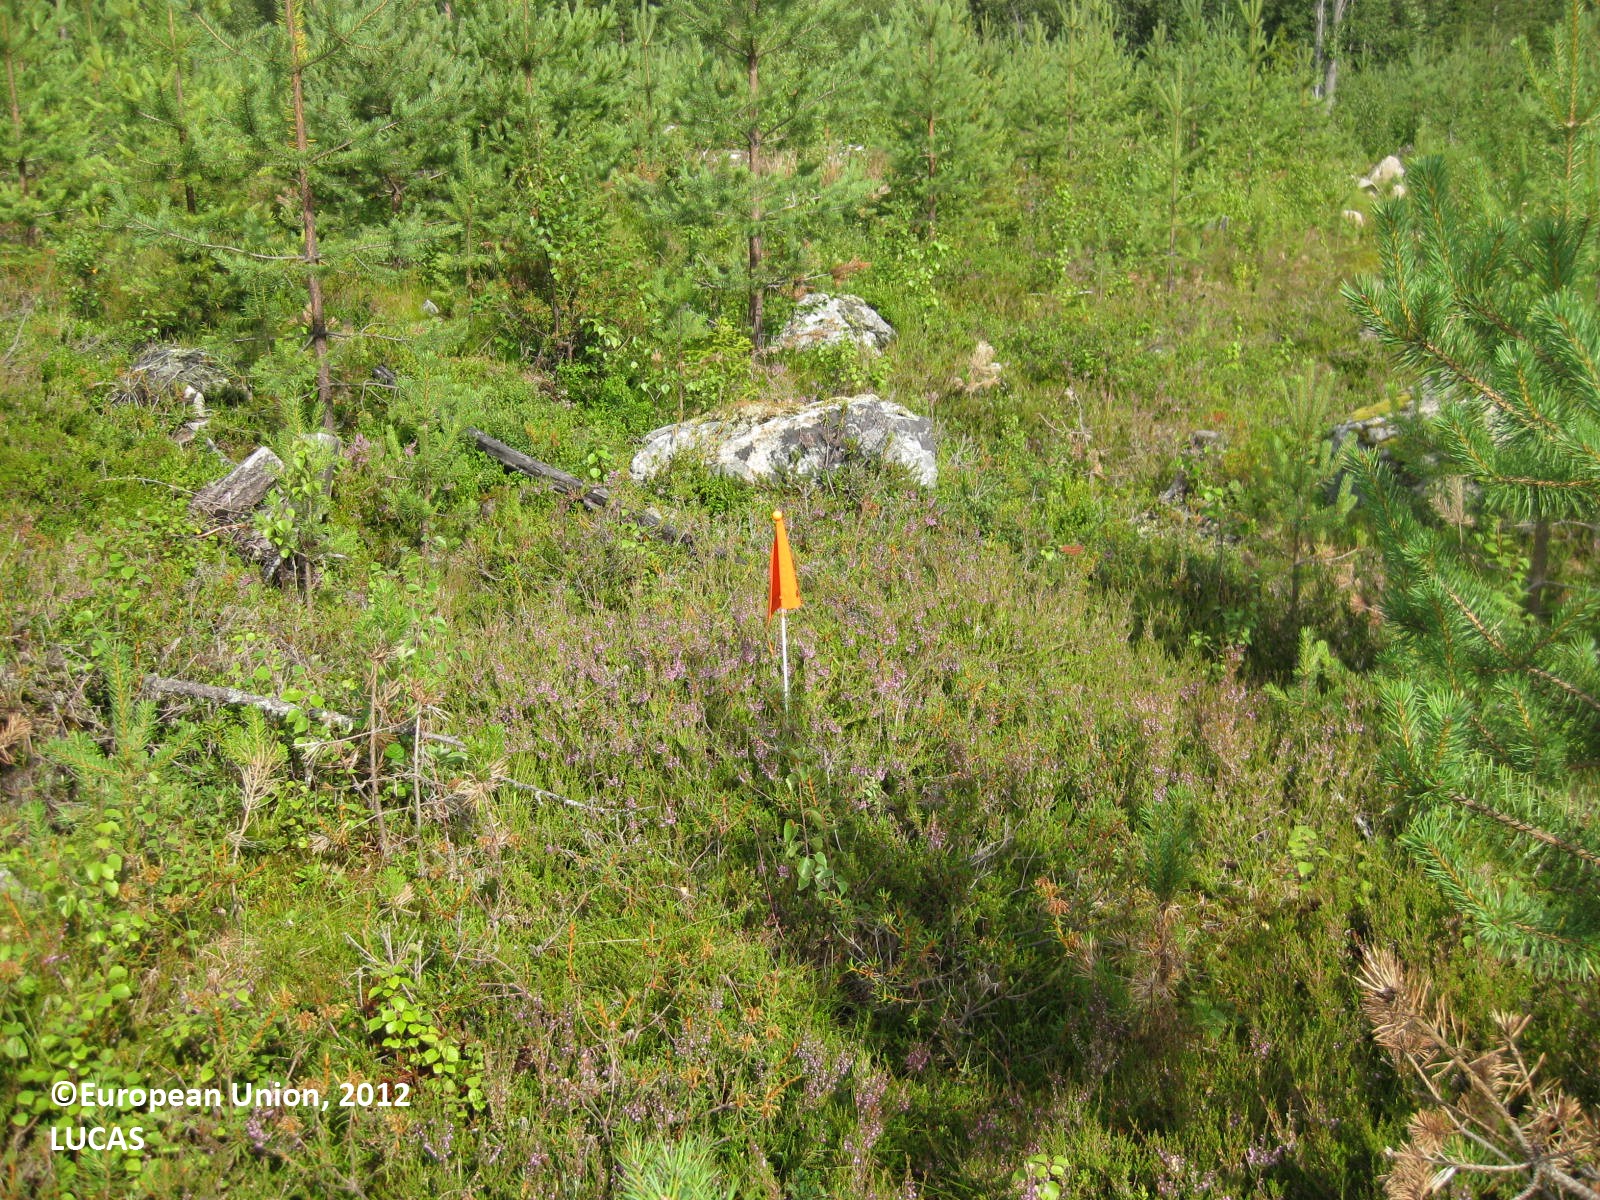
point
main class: Woodland
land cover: Pine dominated mixed woodland
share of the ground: 50 - 75 %
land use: Forestry
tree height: < 5 m
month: July
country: FI
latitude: 65.9332
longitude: 28.6415
